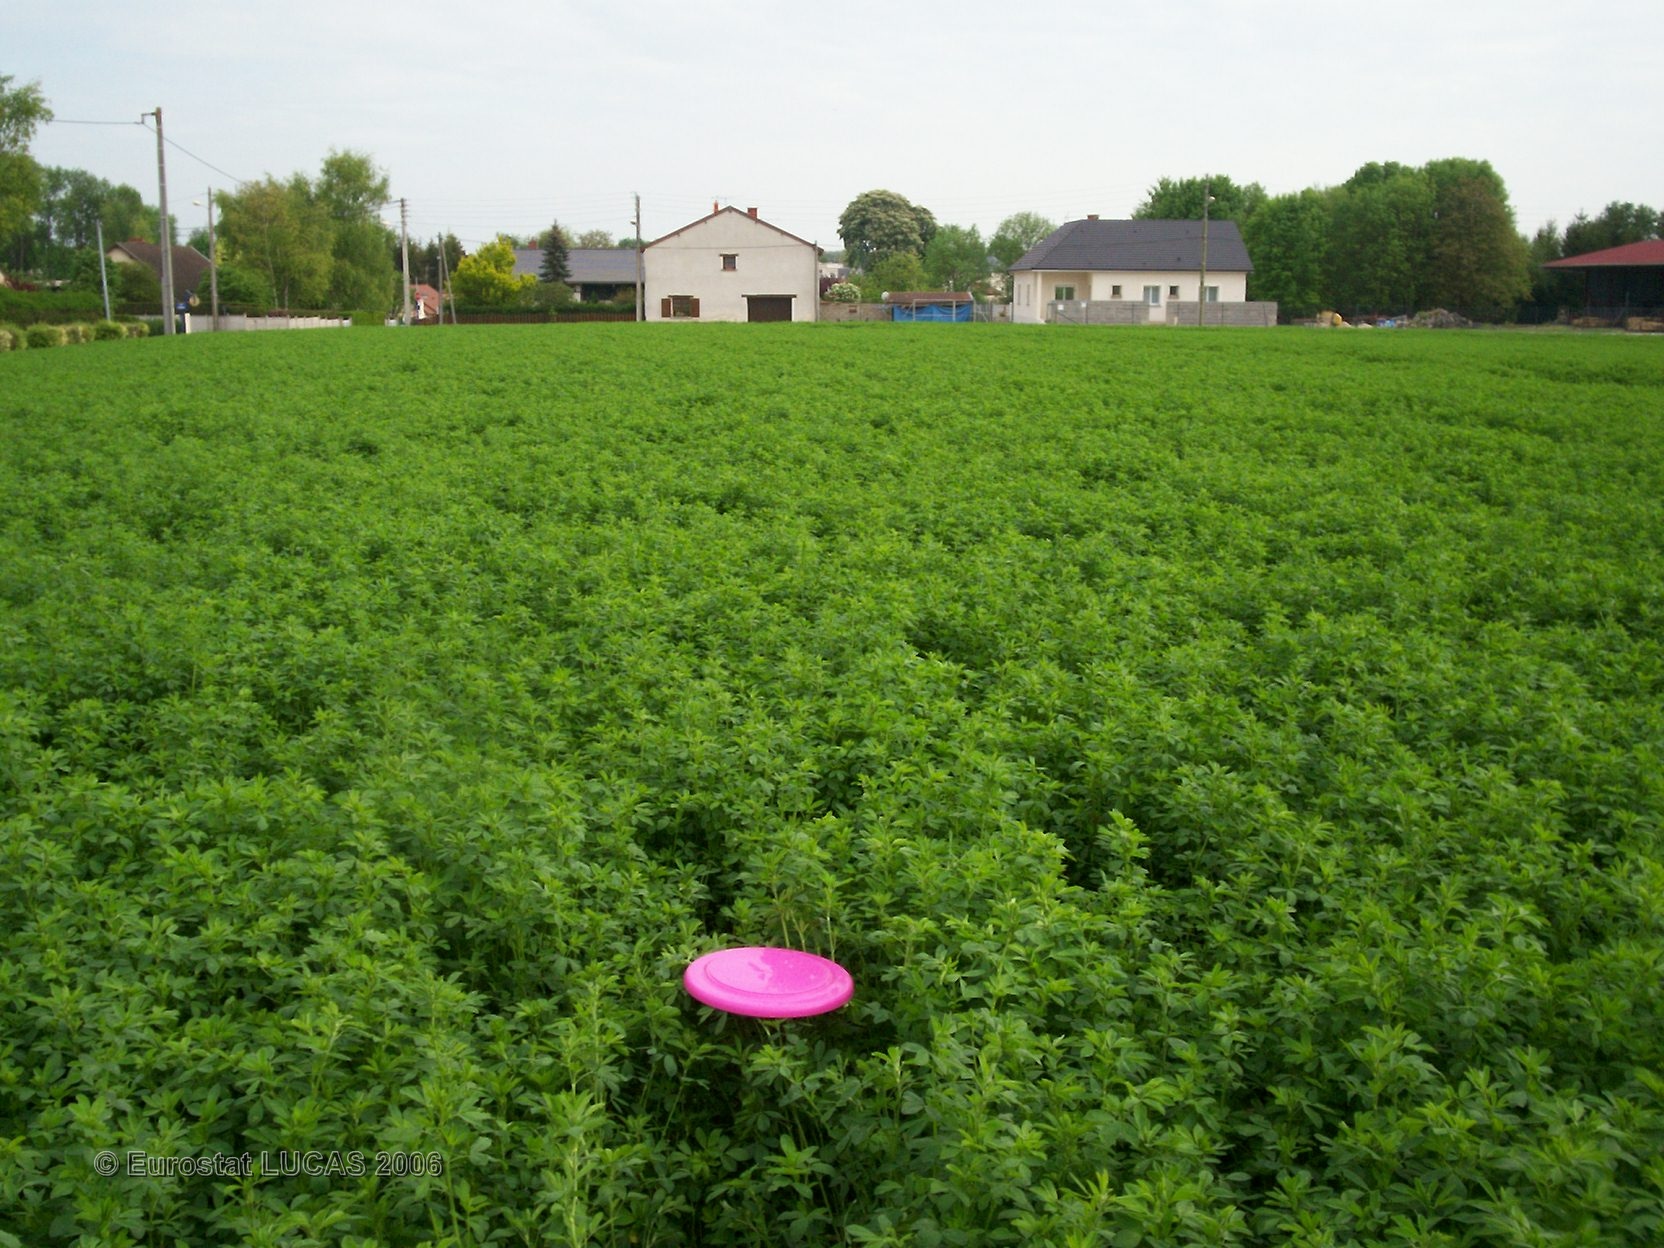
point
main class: Cropland
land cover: Lucerne
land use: Agriculture (excluding fallow land and kitchen gardens)
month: May
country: FR
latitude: 49.1433
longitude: 4.3620
